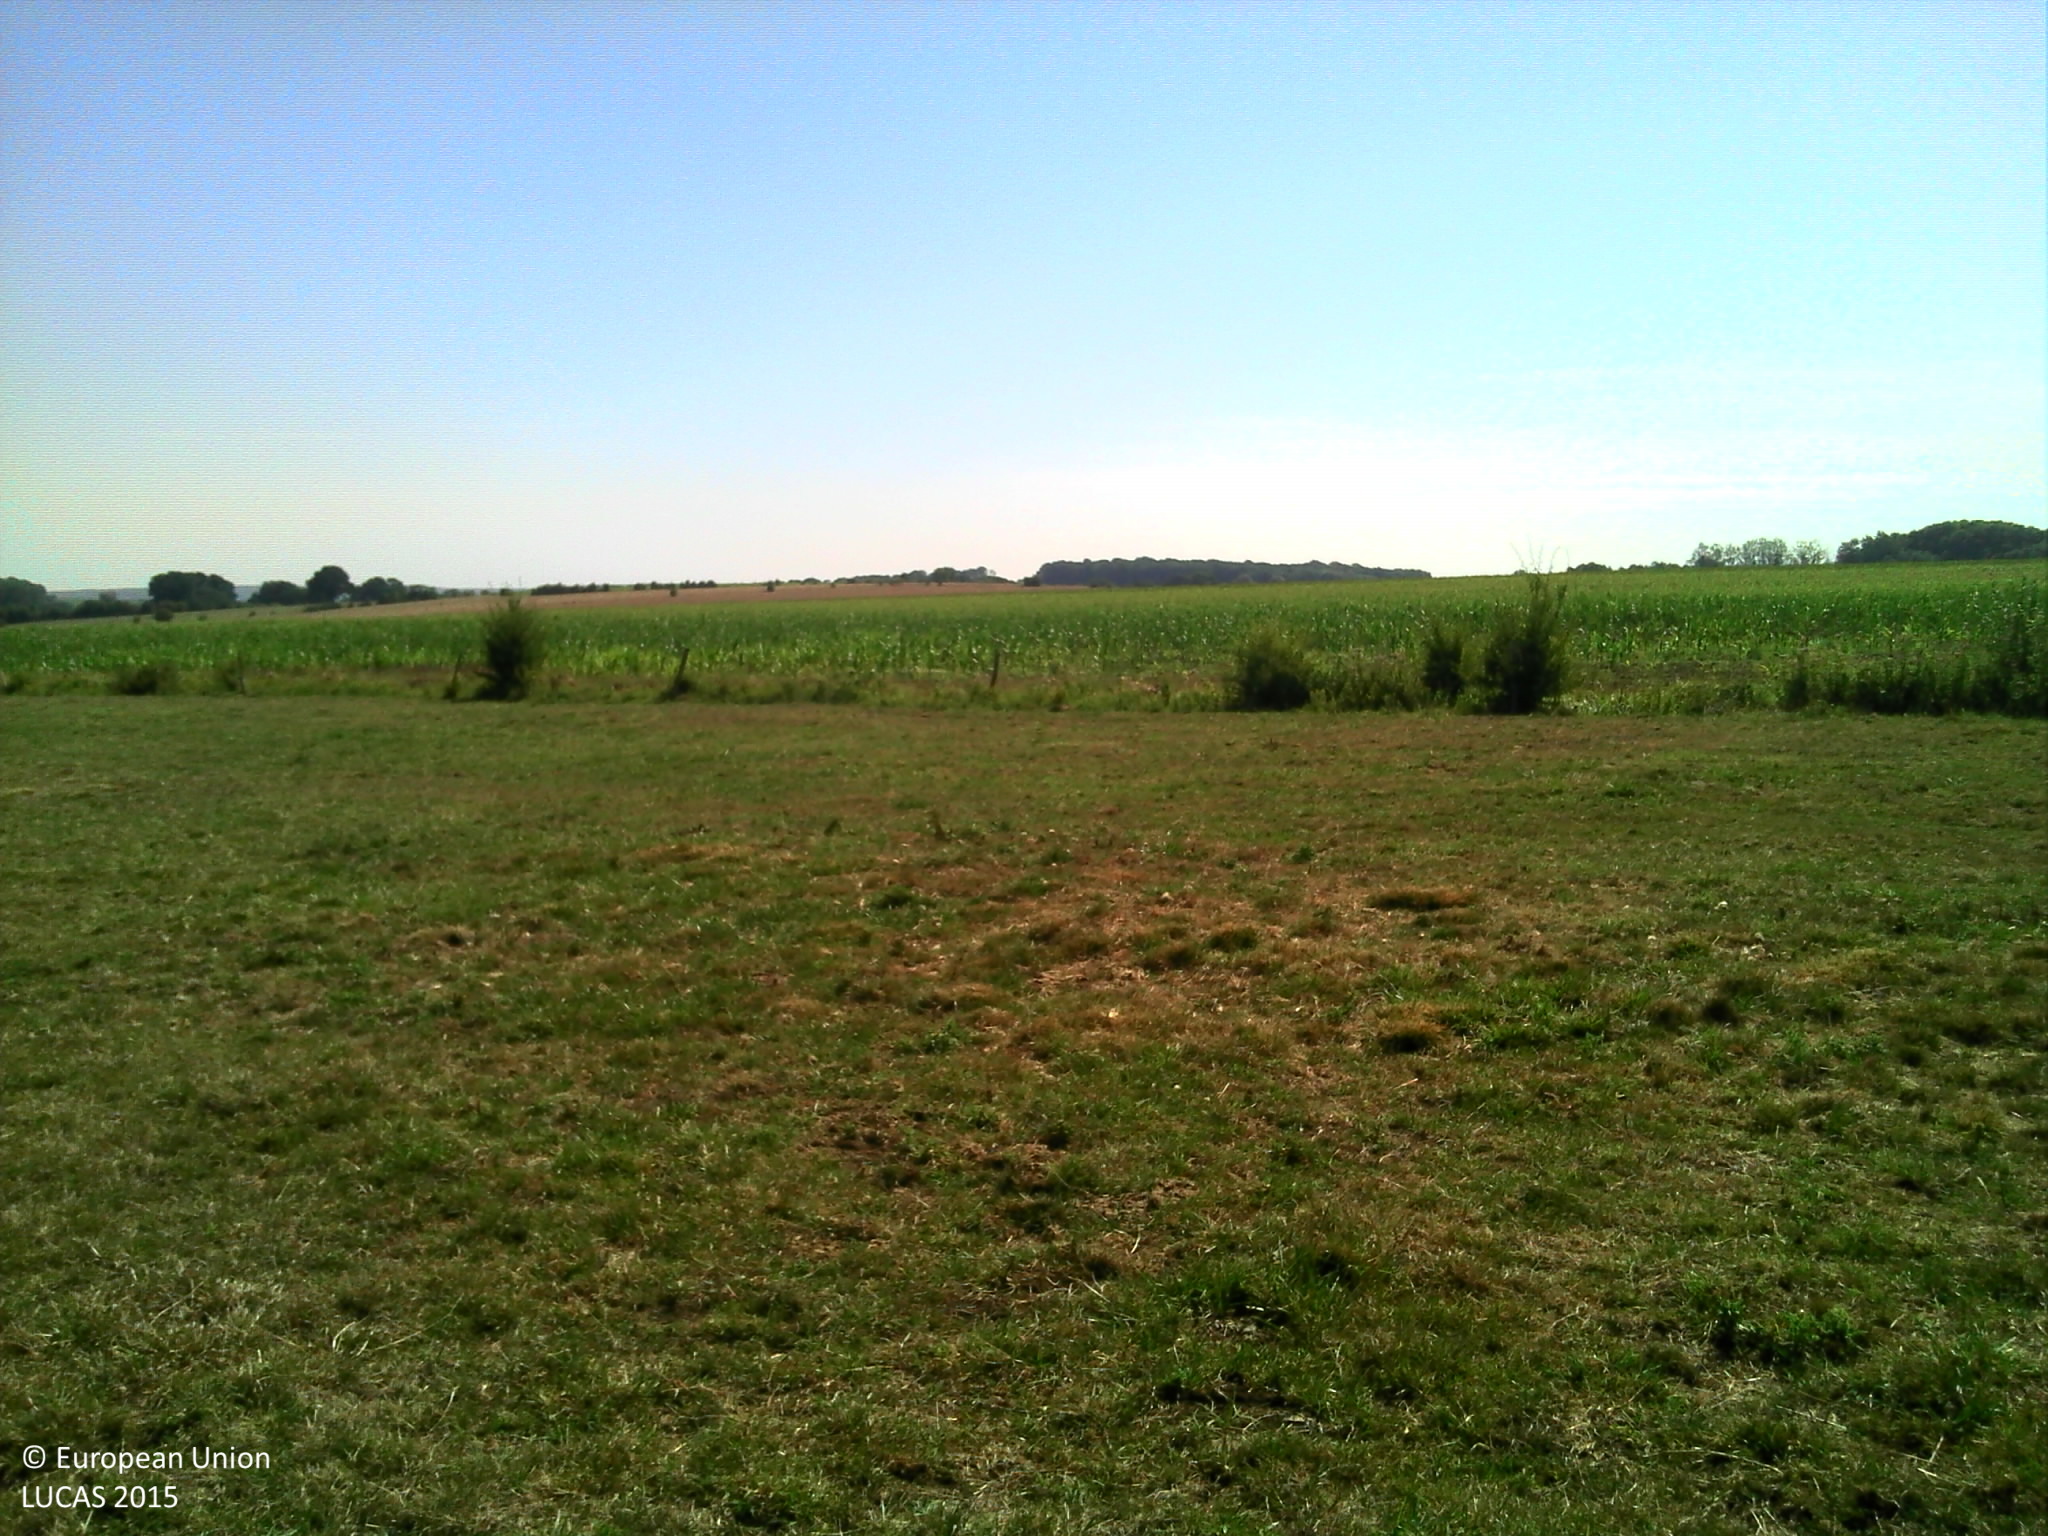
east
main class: Grassland
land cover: Grassland without tree/shrub cover
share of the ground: > 75 %
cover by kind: herbaceous plants 100 %
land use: Agriculture (excluding fallow land and kitchen gardens)
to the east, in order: Grassland without tree/shrub cover; Fences; Ditches and canals; Grassland without tree/shrub cover; Other bare soil; Maize; Fences; Grass margins; Maize
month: August
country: FR
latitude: 49.4496
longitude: 5.1286
